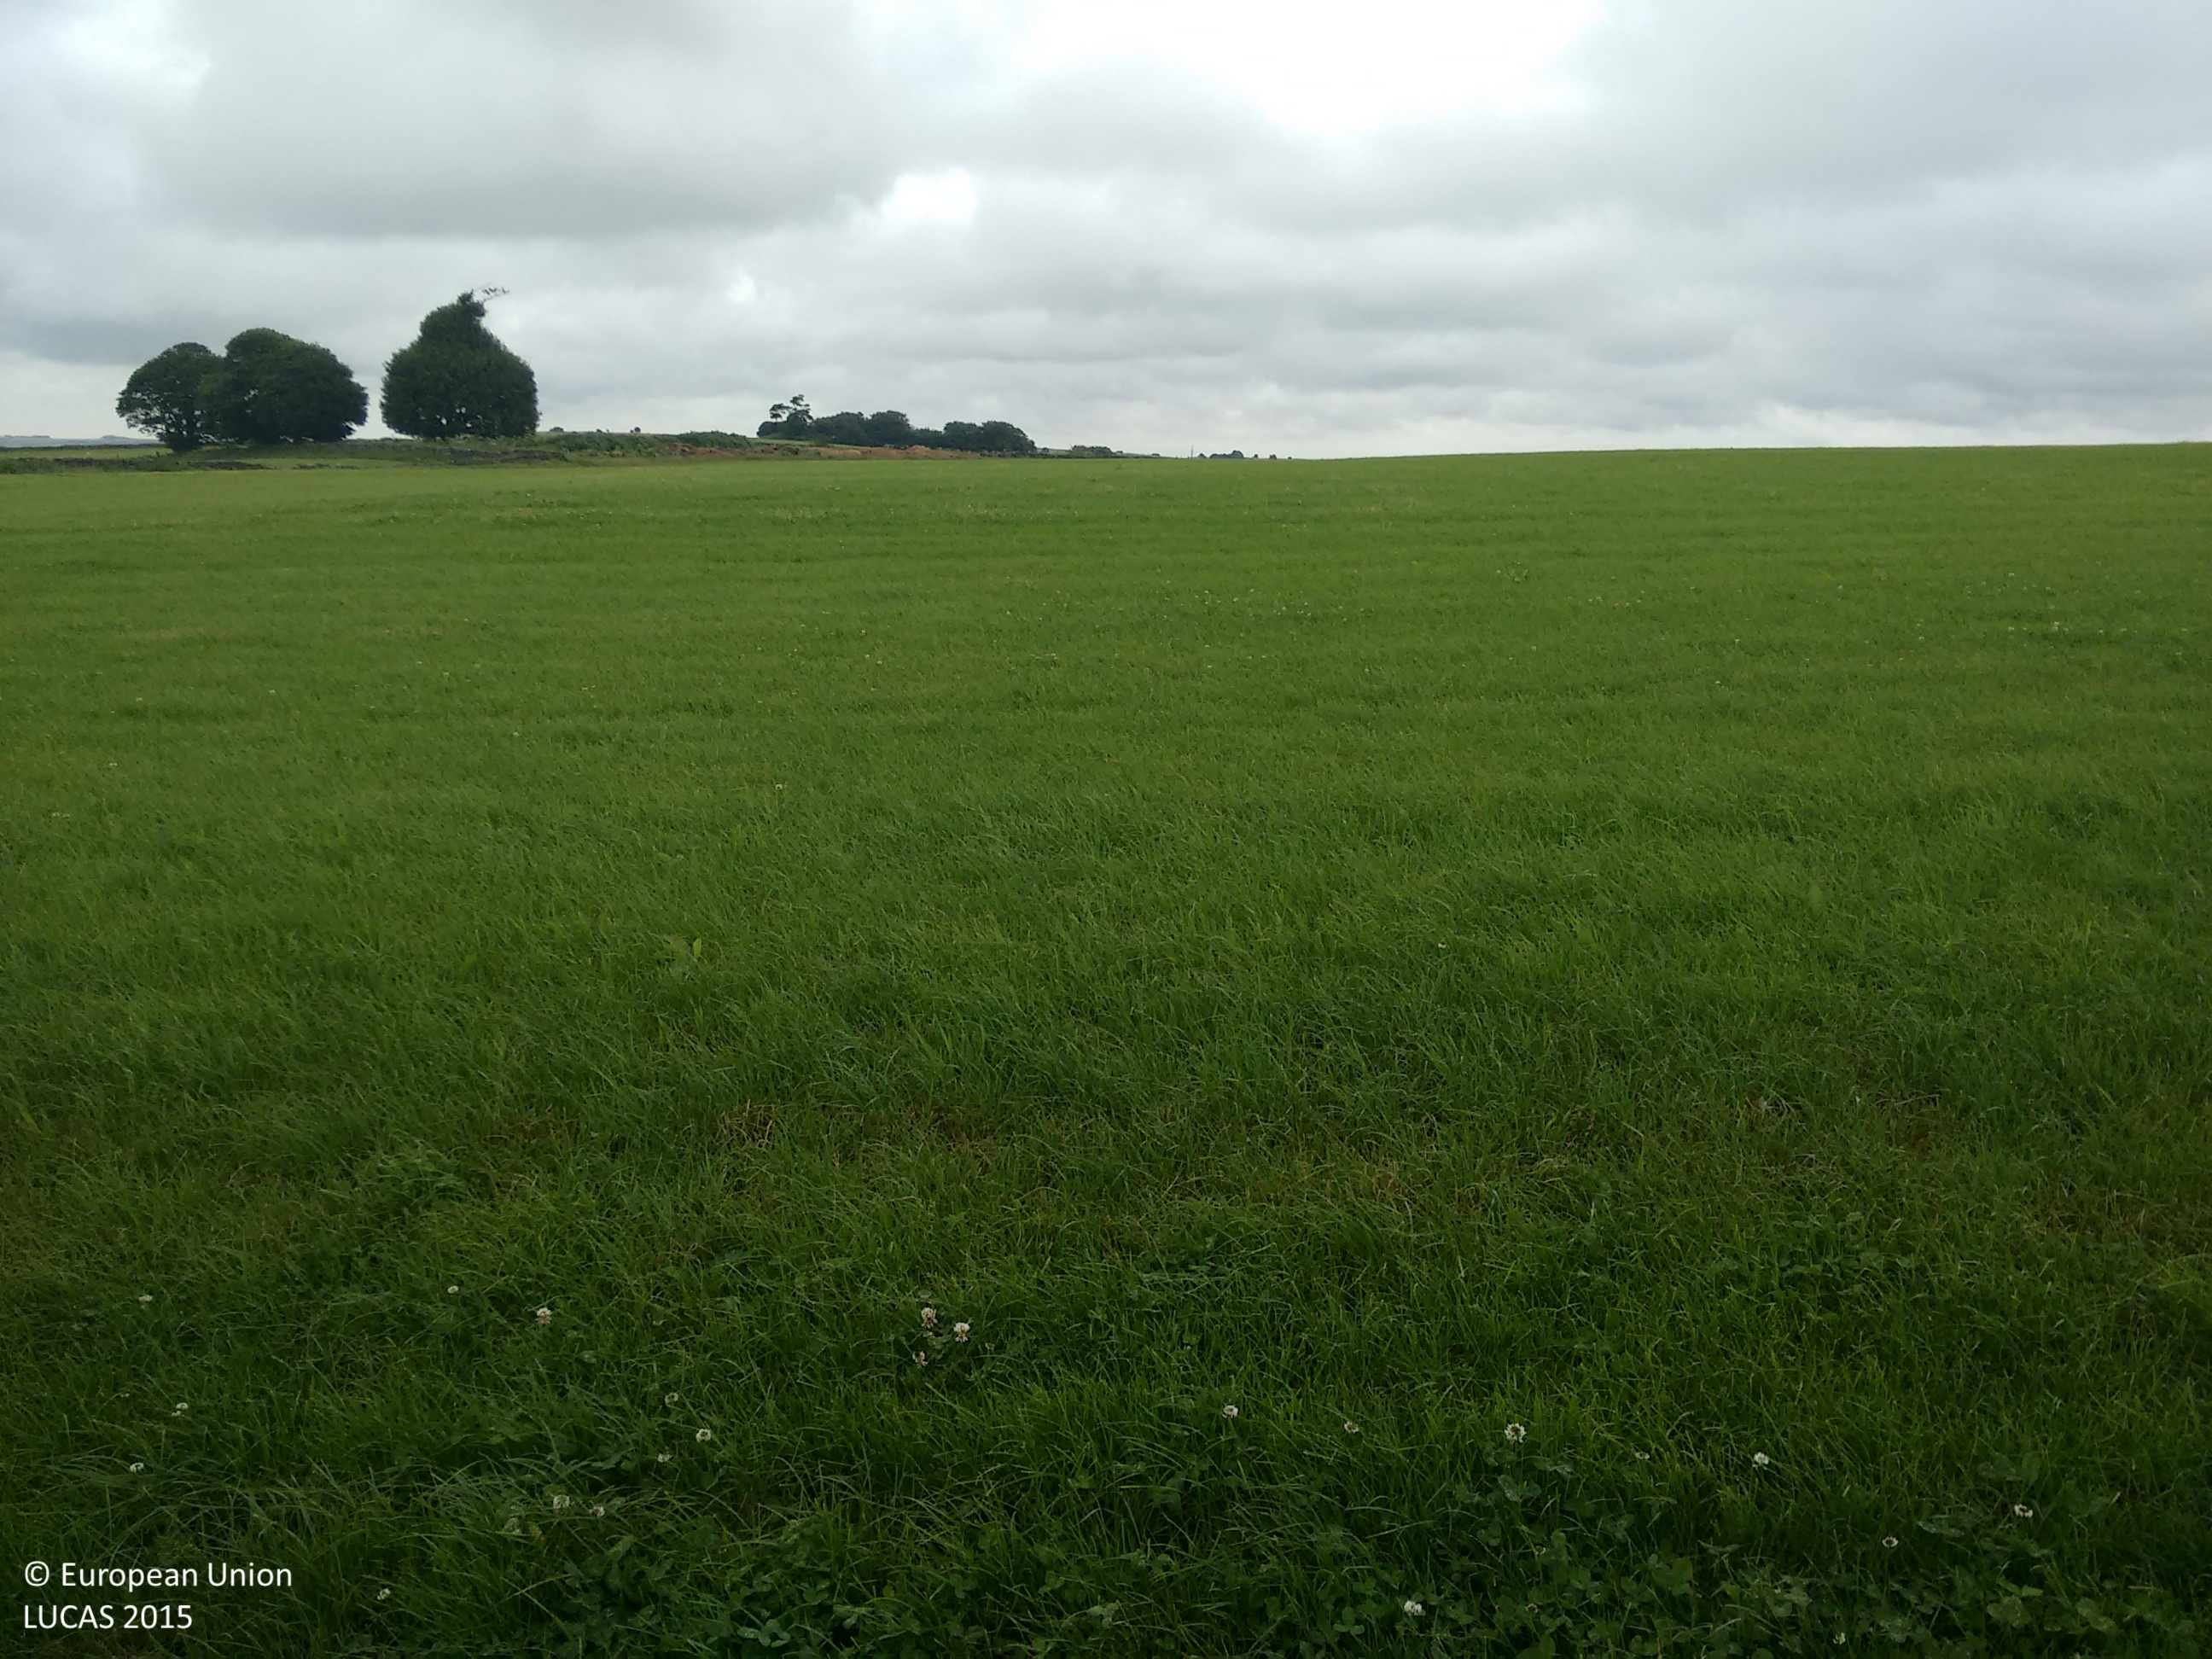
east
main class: Grassland
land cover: Grassland without tree/shrub cover
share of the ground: > 75 %
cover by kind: herbaceous plants 100 %
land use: Agriculture (excluding fallow land and kitchen gardens)
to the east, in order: Grassland without tree/shrub cover; Tracks; Grassland without tree/shrub cover; Dry stone walls; Grassland without tree/shrub cover
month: July
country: GB
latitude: 53.0942
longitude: -1.6255
